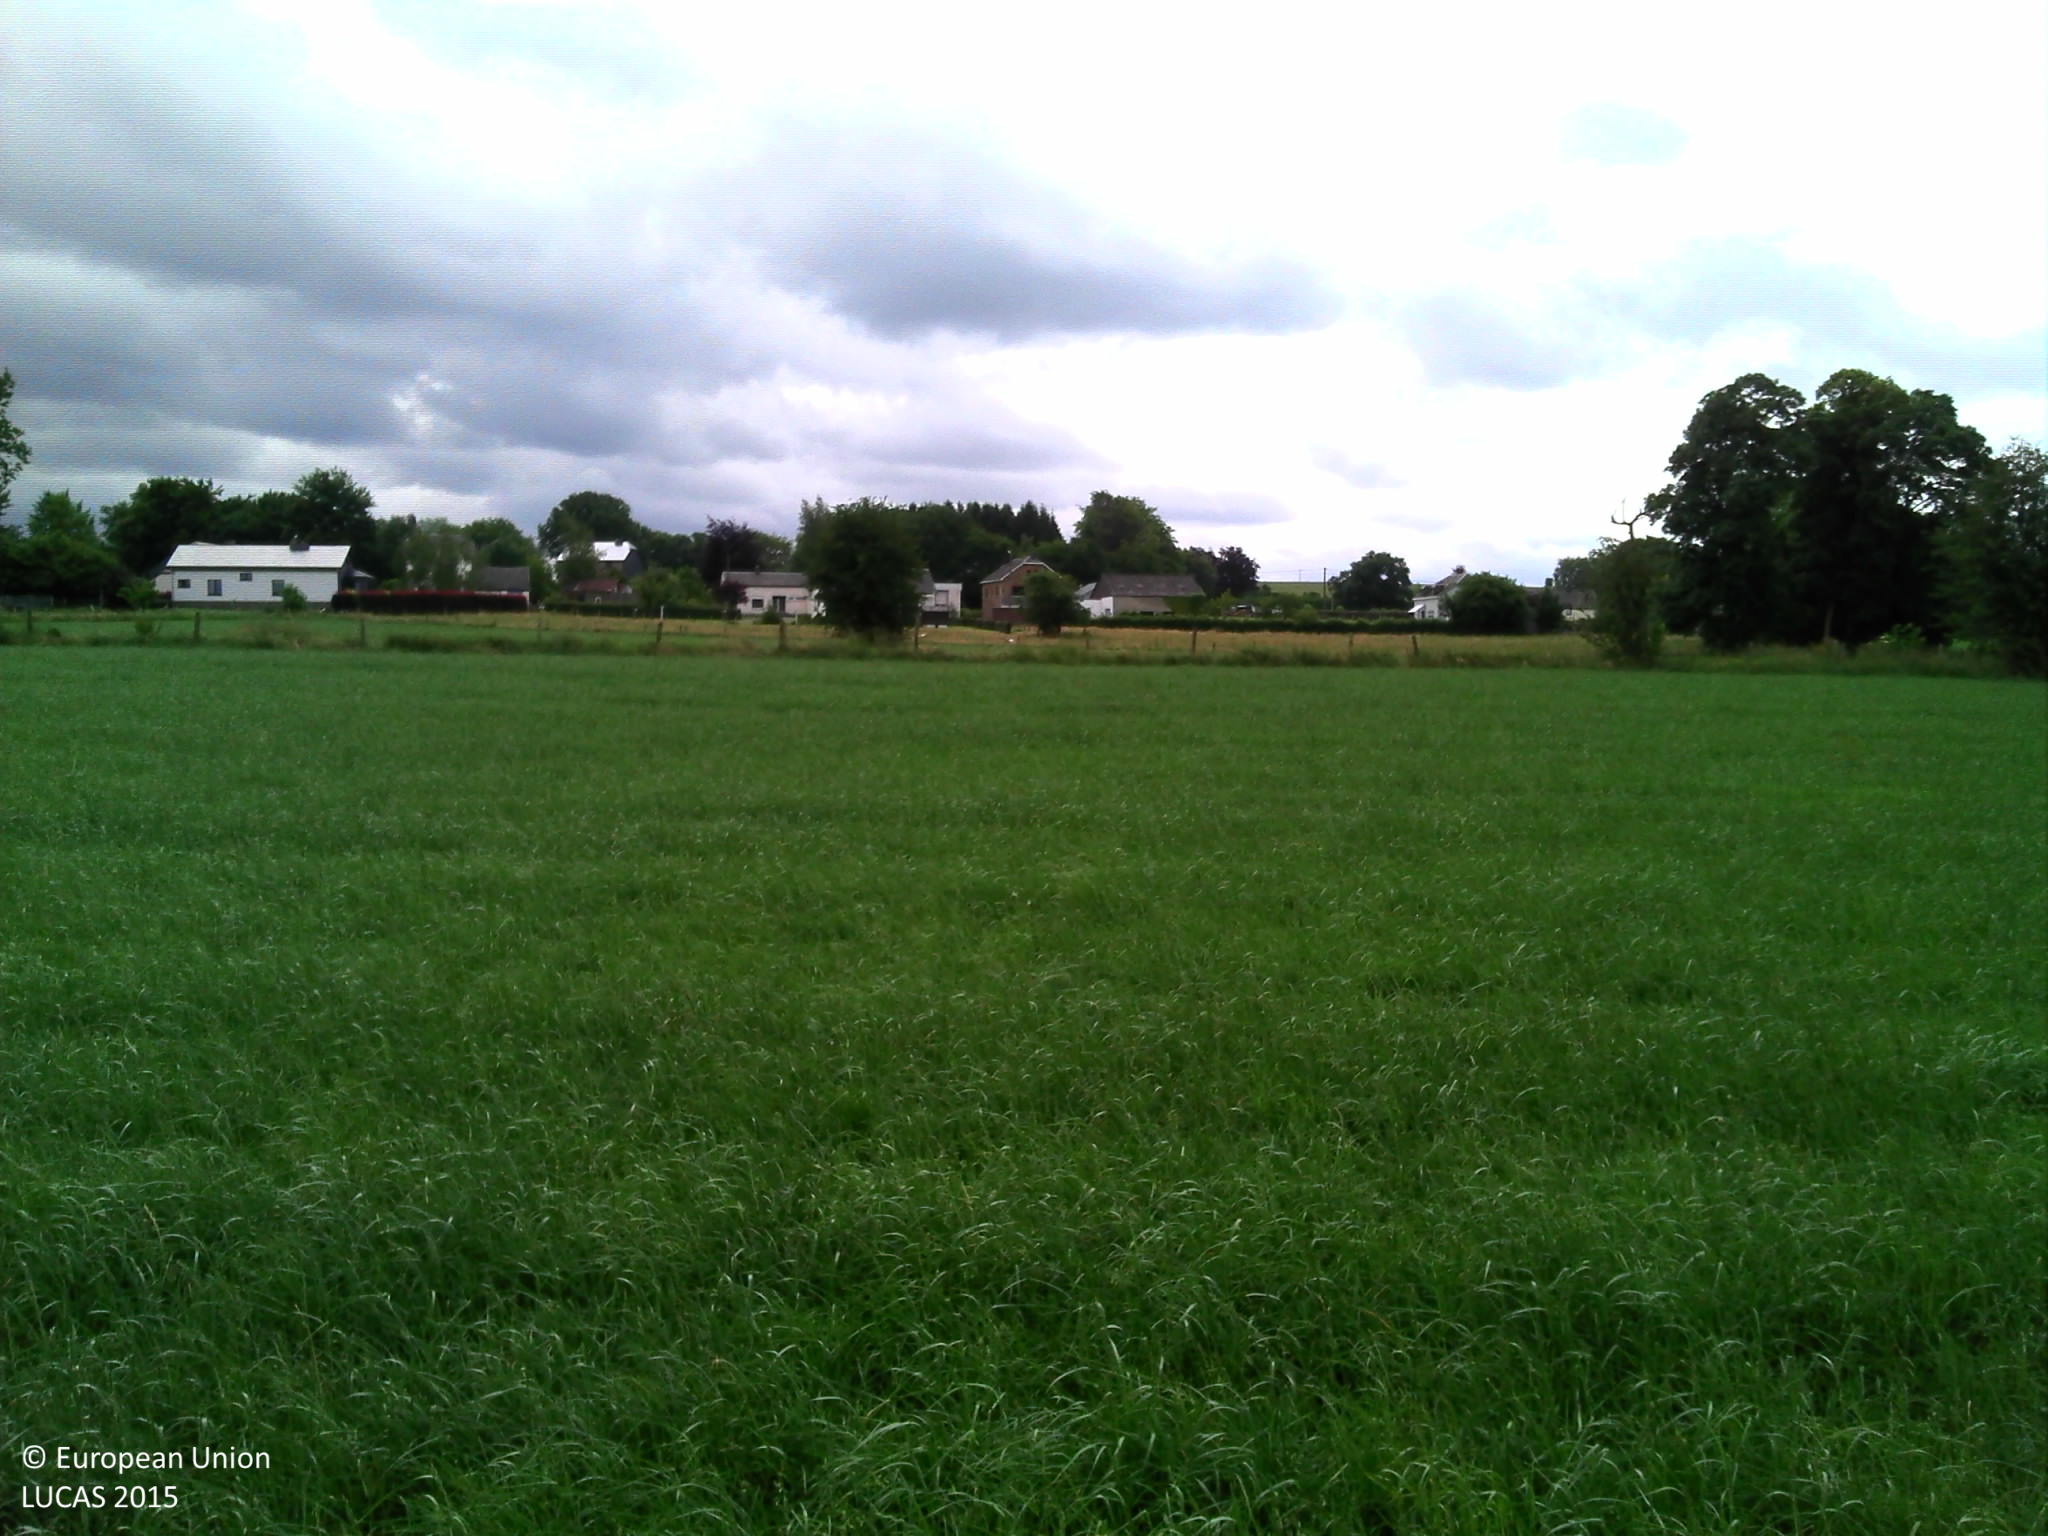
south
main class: Grassland
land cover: Grassland without tree/shrub cover
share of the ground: > 75 %
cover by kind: herbaceous plants 100 %
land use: Agriculture (excluding fallow land and kitchen gardens)
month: July
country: BE
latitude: 50.1465
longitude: 5.8987
